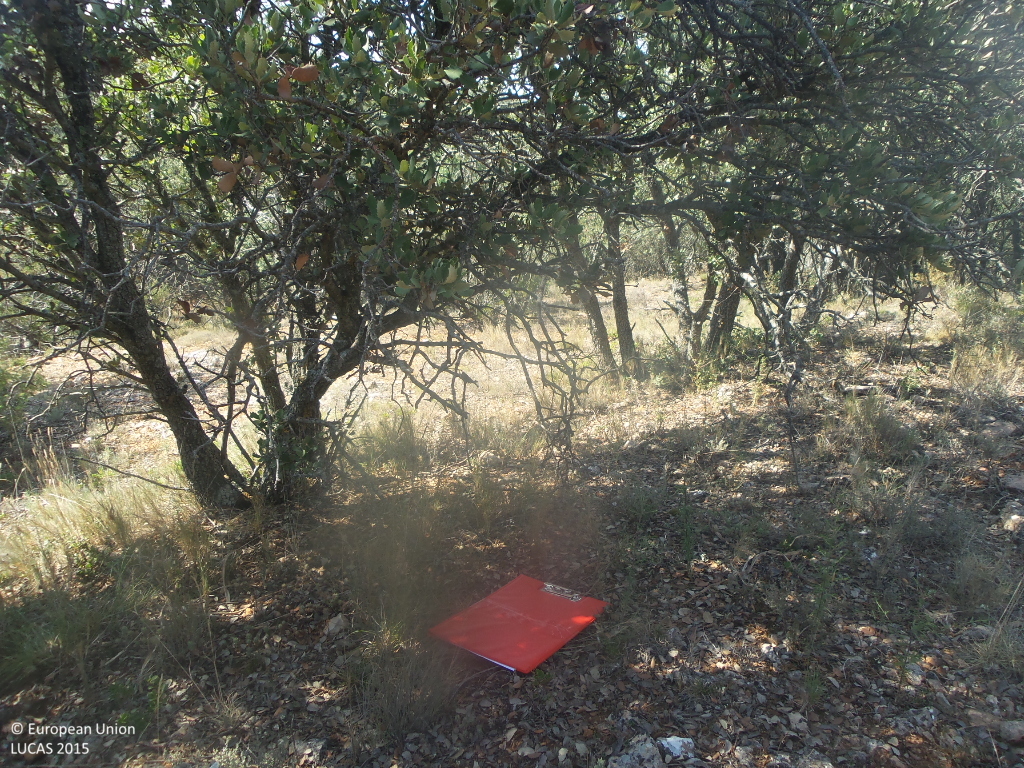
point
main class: Woodland
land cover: Other mixed woodland
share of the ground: 50 - 75 %
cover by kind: coniferous forest trees 40 %, broadleaved forest trees 20 %, shrubs 20 %, herbaceous plants 10 %, unconsolidated bare surface 10 %
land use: Semi-natural and natural areas not in use
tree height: < 5 m
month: July
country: ES
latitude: 41.1594
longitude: -2.0998
